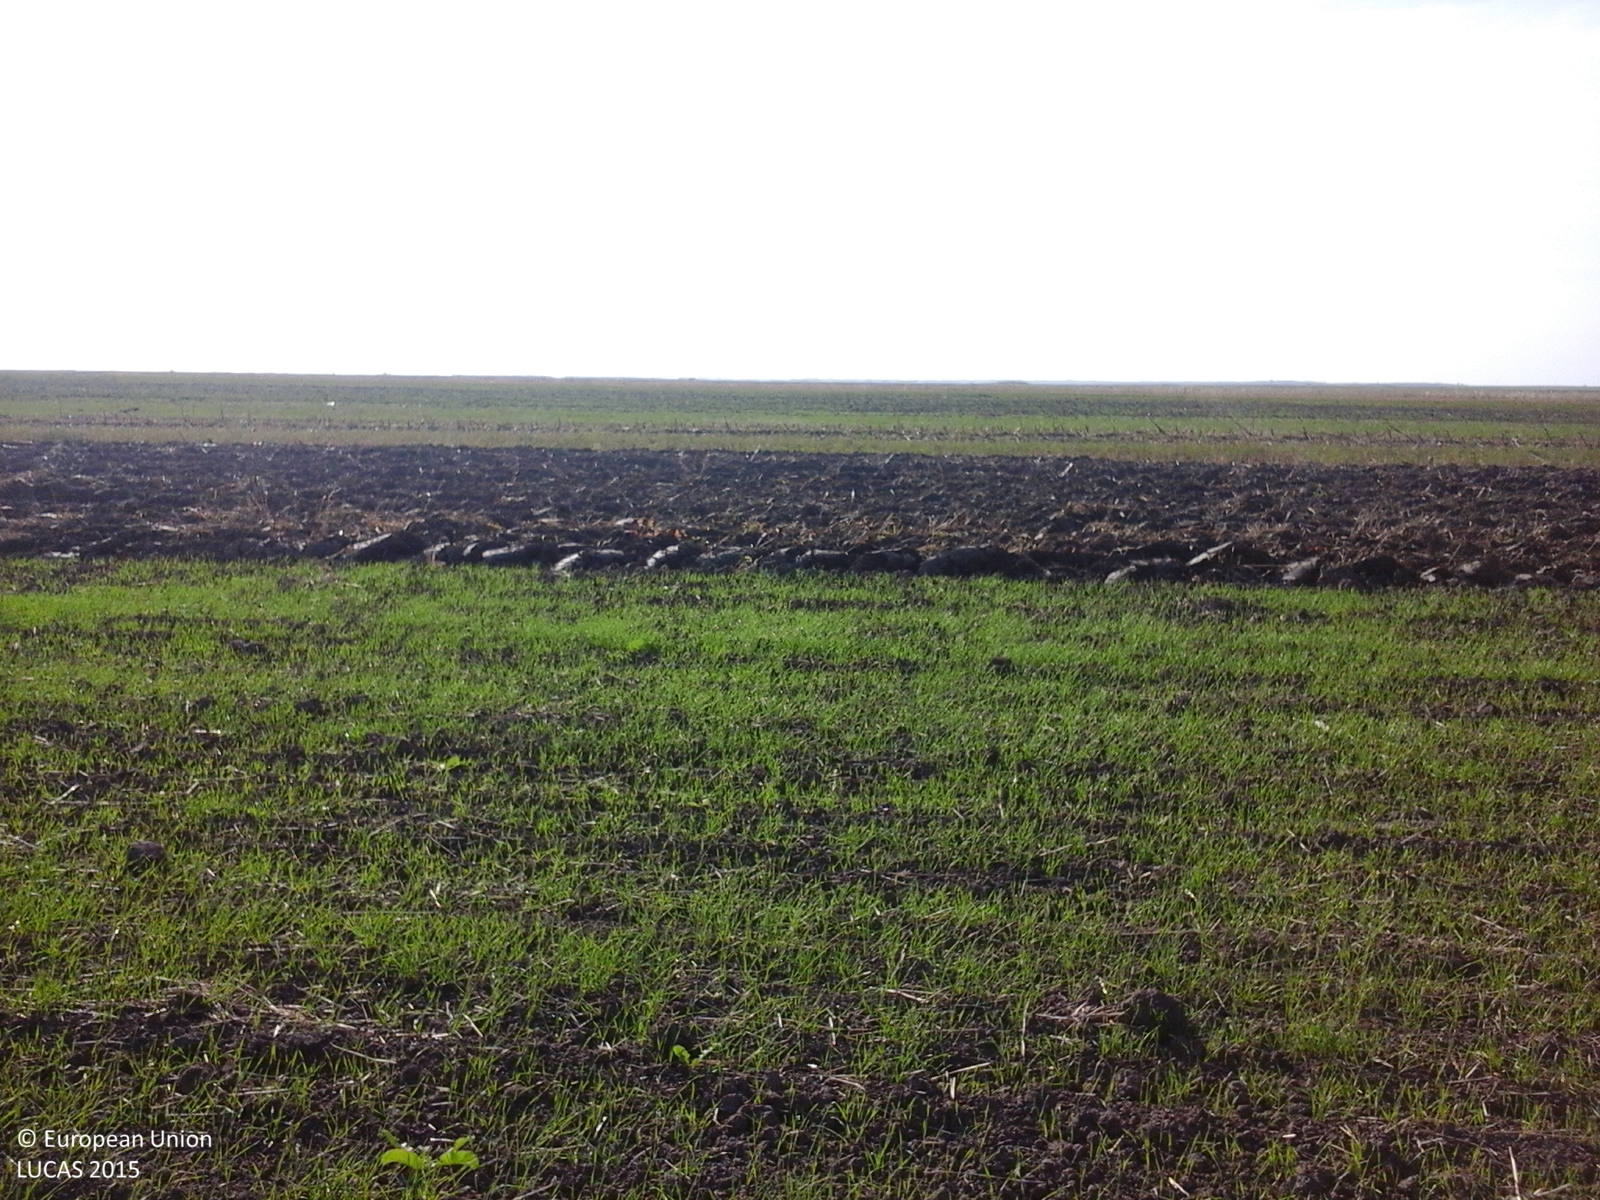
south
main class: Cropland
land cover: Common wheat
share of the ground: 10 - 25 %
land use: Agriculture (excluding fallow land and kitchen gardens)
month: October
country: RO
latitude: 45.5608
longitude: 27.1445
